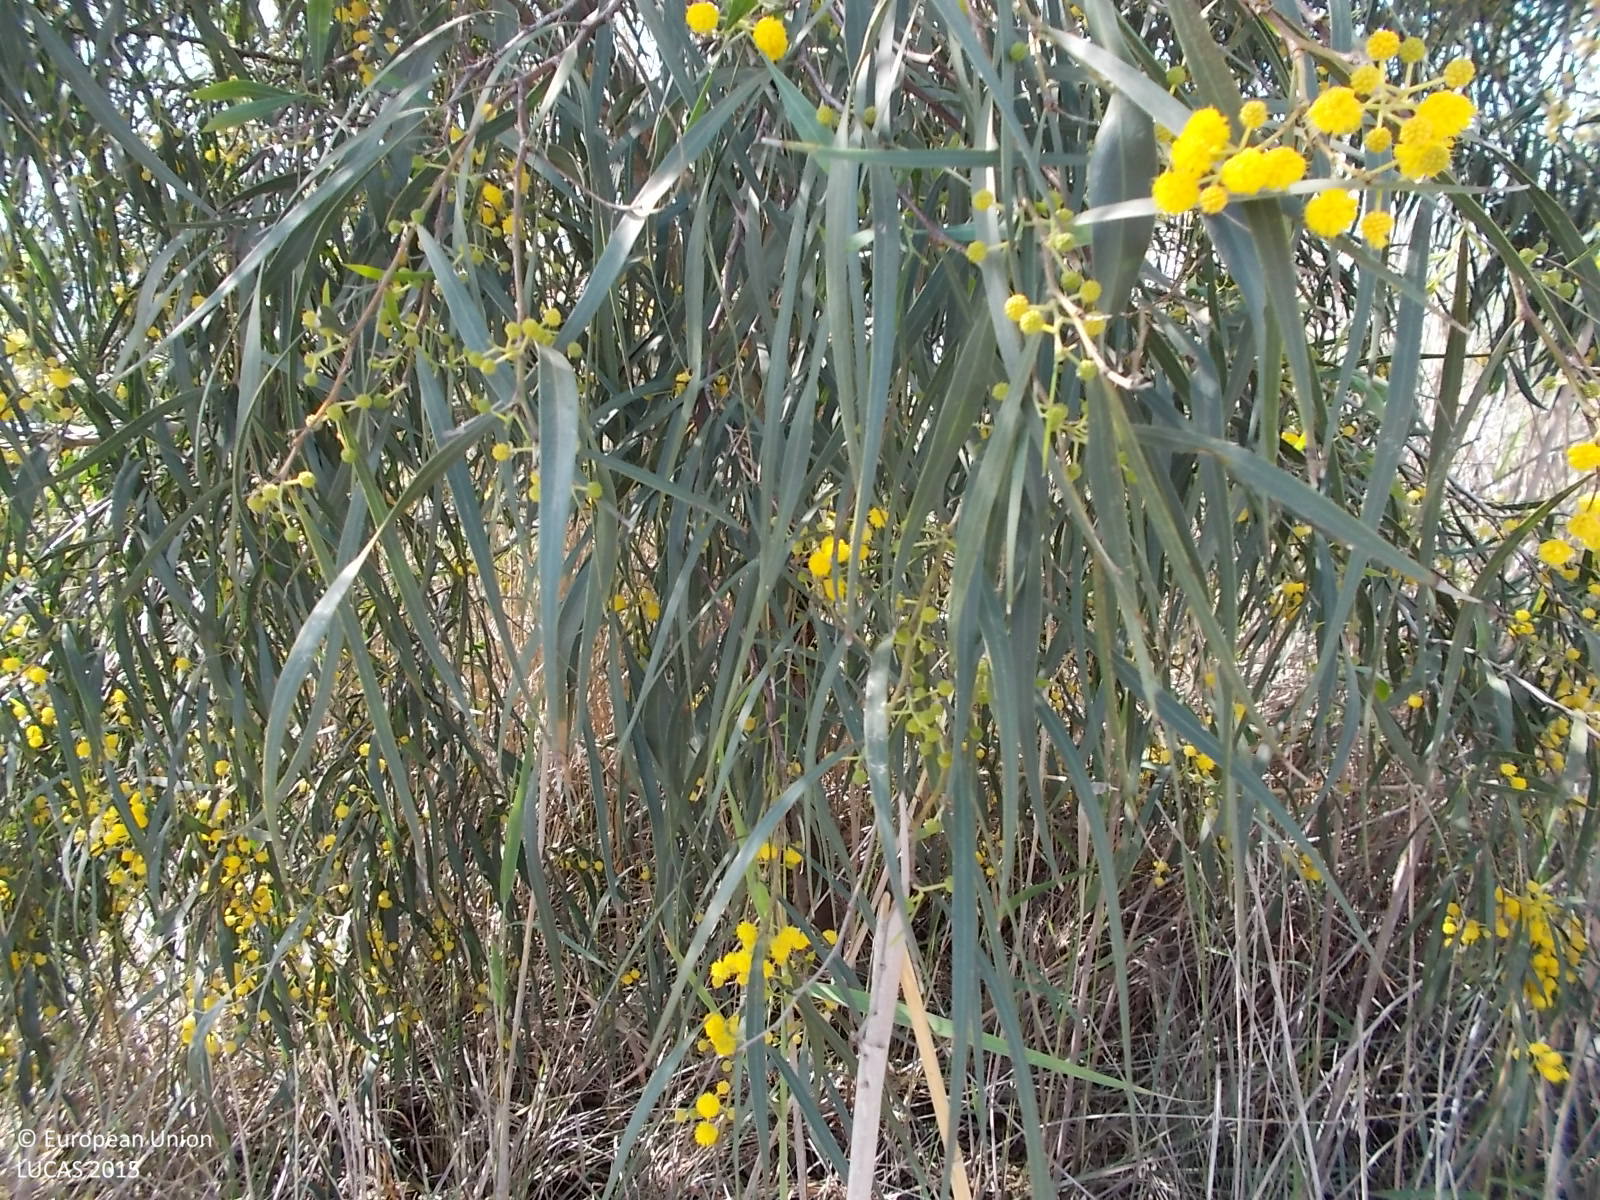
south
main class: Grassland
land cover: Grassland with sparse tree/shrub cover
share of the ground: > 75 %
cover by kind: herbaceous plants 95 %, broadleaved forest trees 5 %
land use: Semi-natural and natural areas not in use
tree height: < 5 m
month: April
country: CY
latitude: 35.0516
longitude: 33.8136
